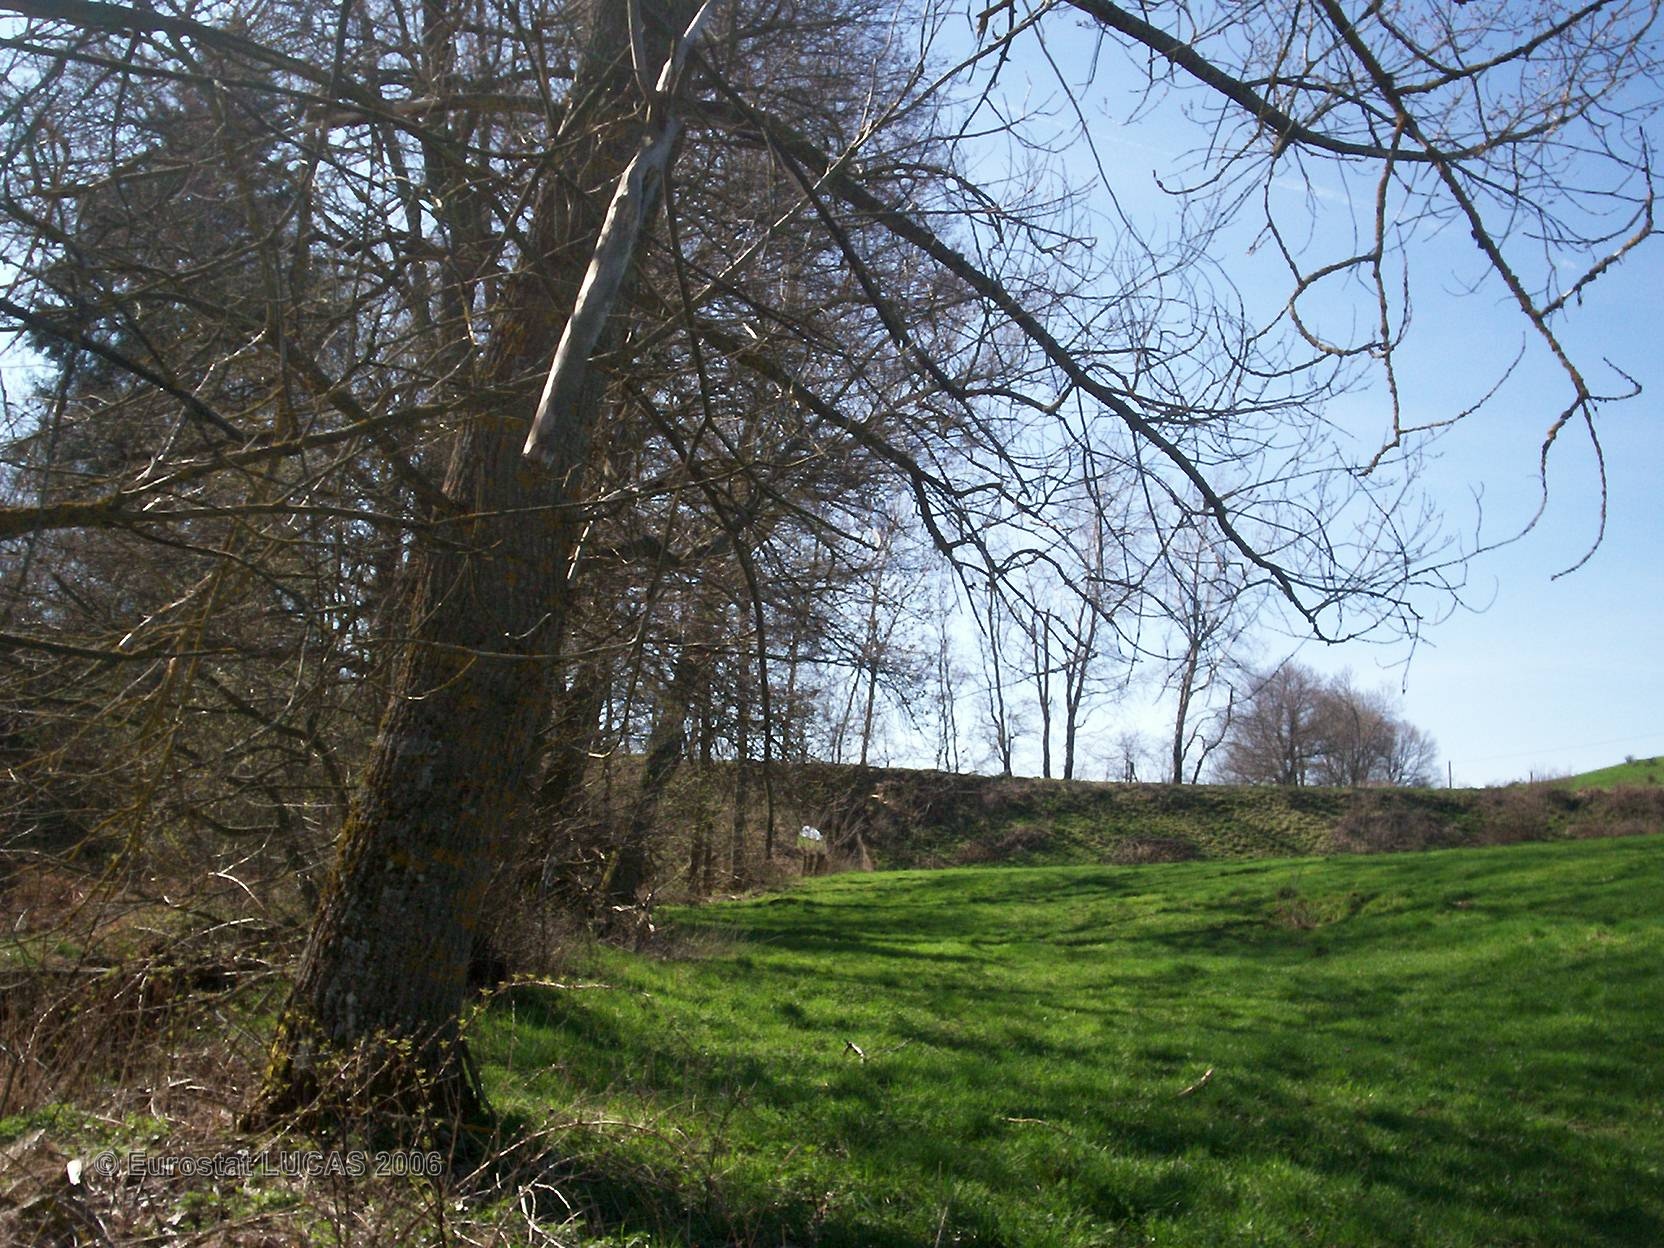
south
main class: Grassland
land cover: Grassland without tree/shrub cover
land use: Agriculture (excluding fallow land and kitchen gardens)
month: April
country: FR
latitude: 45.1817
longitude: 4.1884
